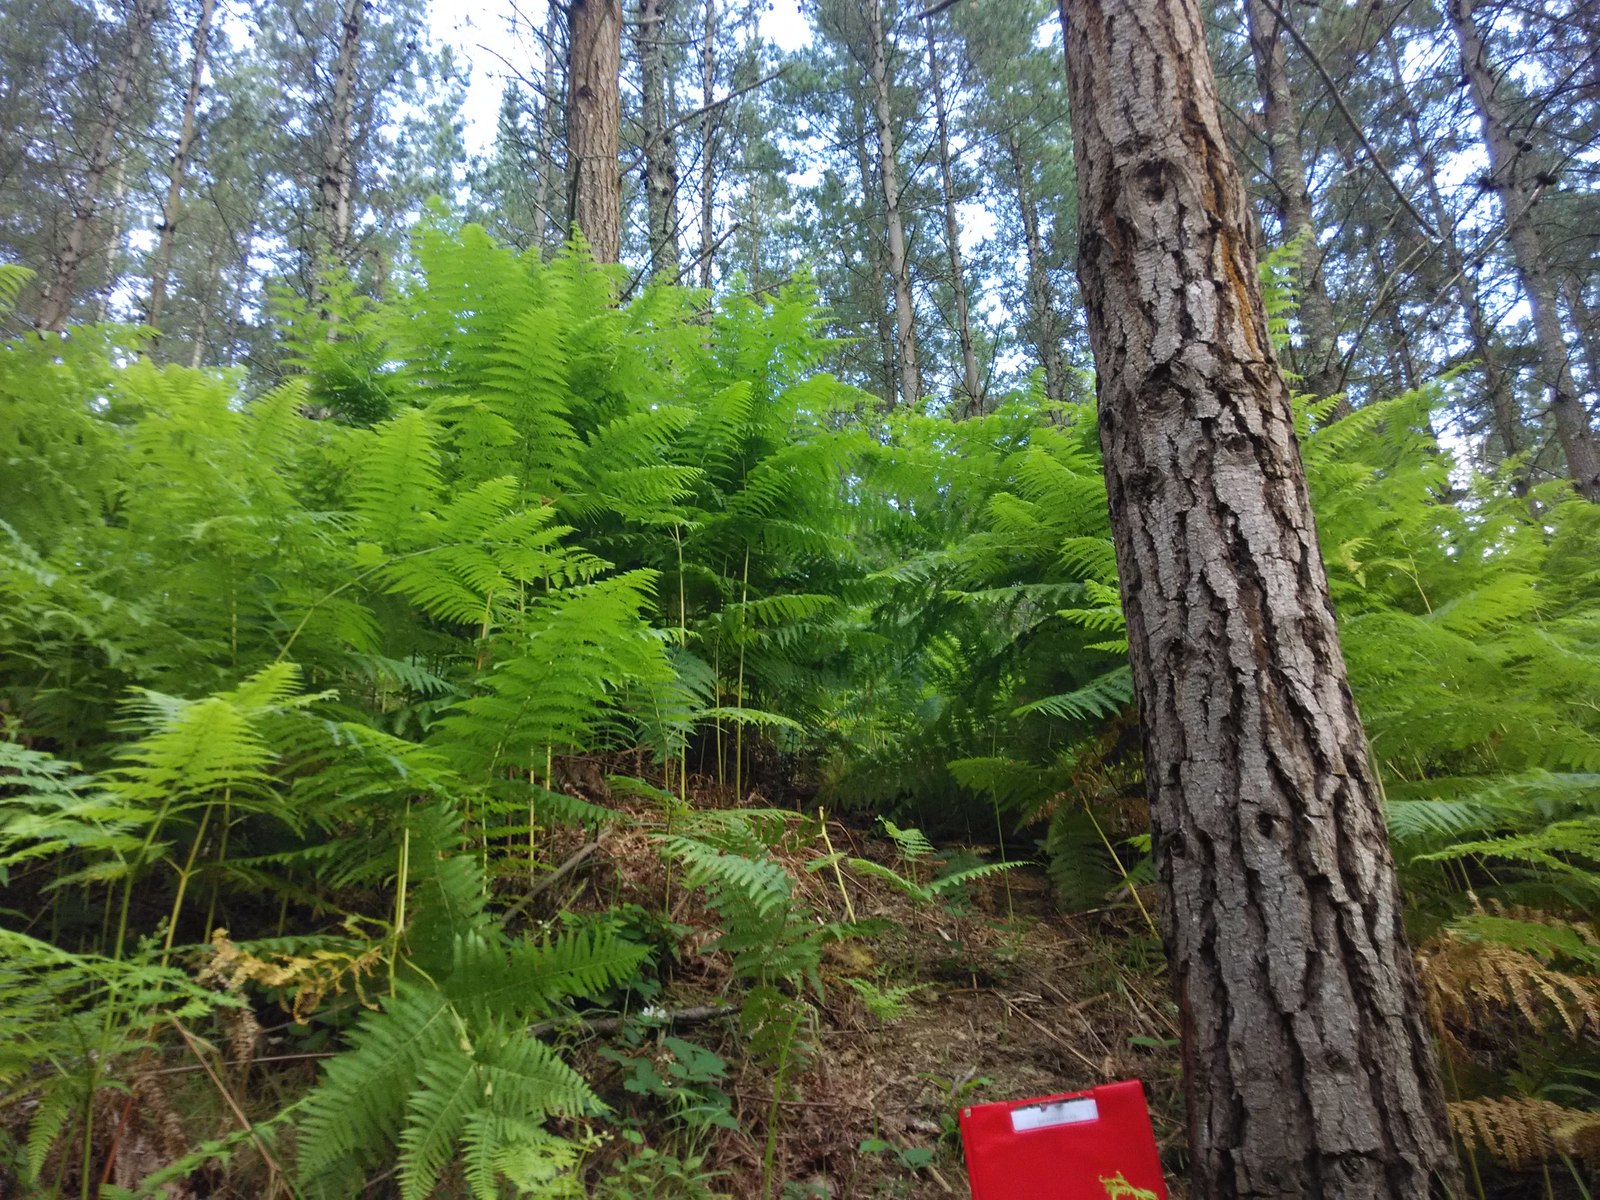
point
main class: Woodland
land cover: Pine dominated coniferous woodland
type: exotic forest
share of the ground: > 75 %
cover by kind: coniferous forest trees 100 %
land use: Forestry
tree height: > 5 m
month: June
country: ES
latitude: 43.3185
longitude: -2.4950
